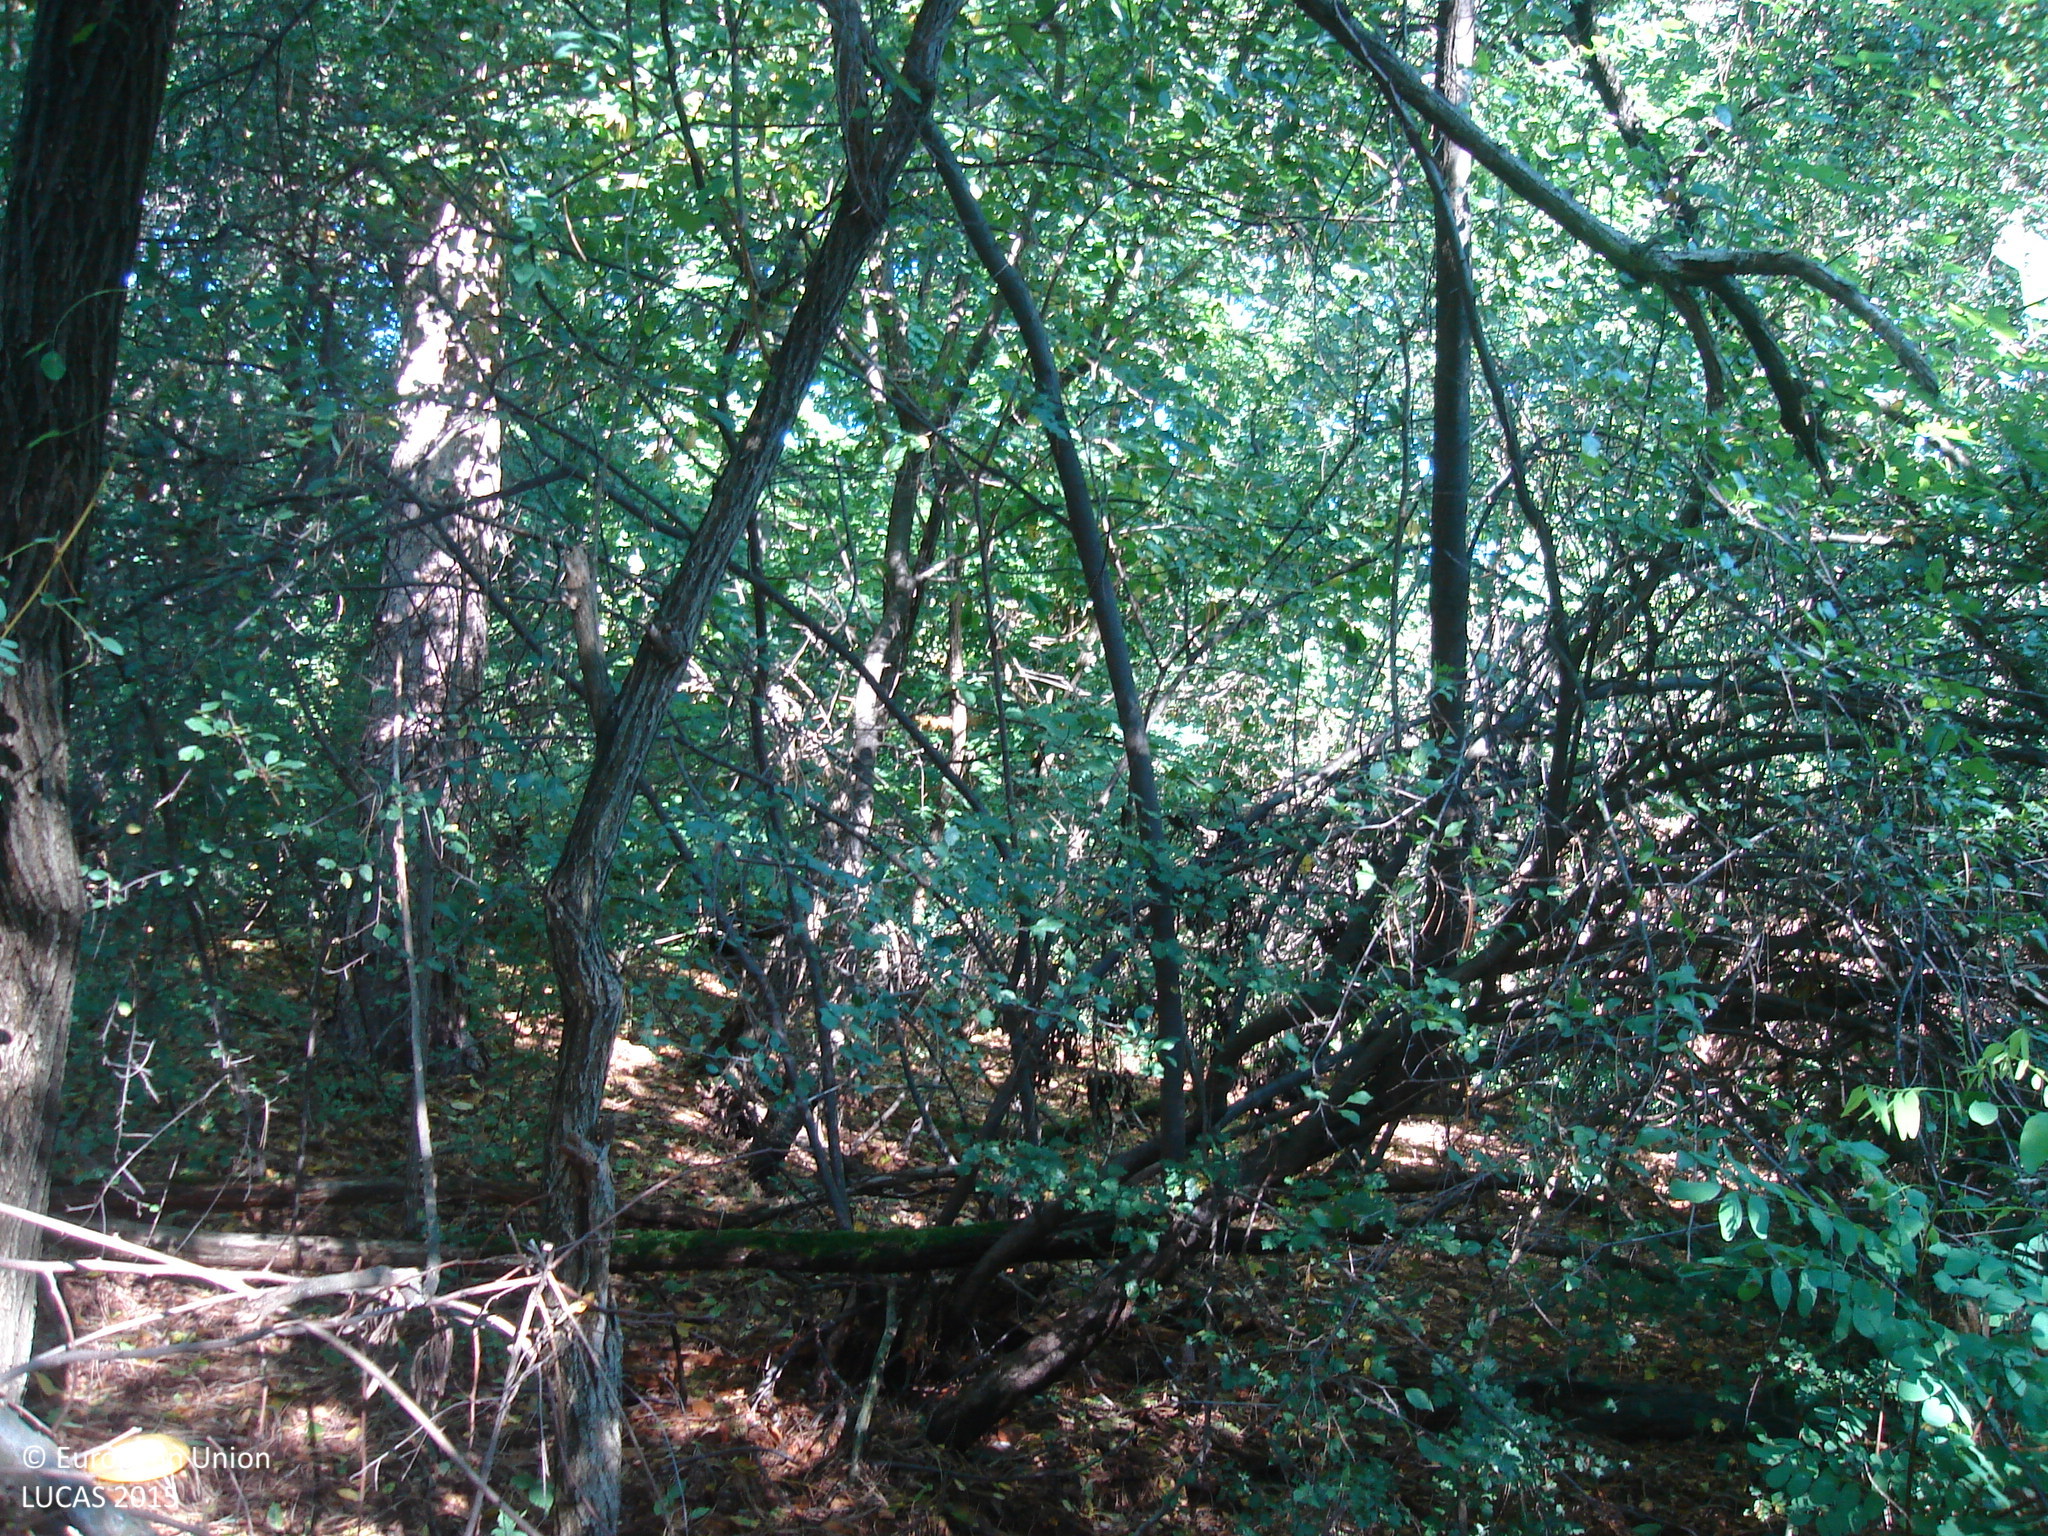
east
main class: Woodland
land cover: Broadleaved woodland
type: mesophytic deciduous forest
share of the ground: > 75 %
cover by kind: broadleaved forest trees 80 %, consolidated bare surface 15 %, shrubs 5 %
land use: Forestry
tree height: > 5 m
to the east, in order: Broadleaved woodland; Ditches and canals; Pine dominated coniferous woodland; Ditches and canals; Broadleaved woodland; Rivers and streams; Rocks and stones; Broadleaved woodland
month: September
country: BG
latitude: 42.3648
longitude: 23.9186
